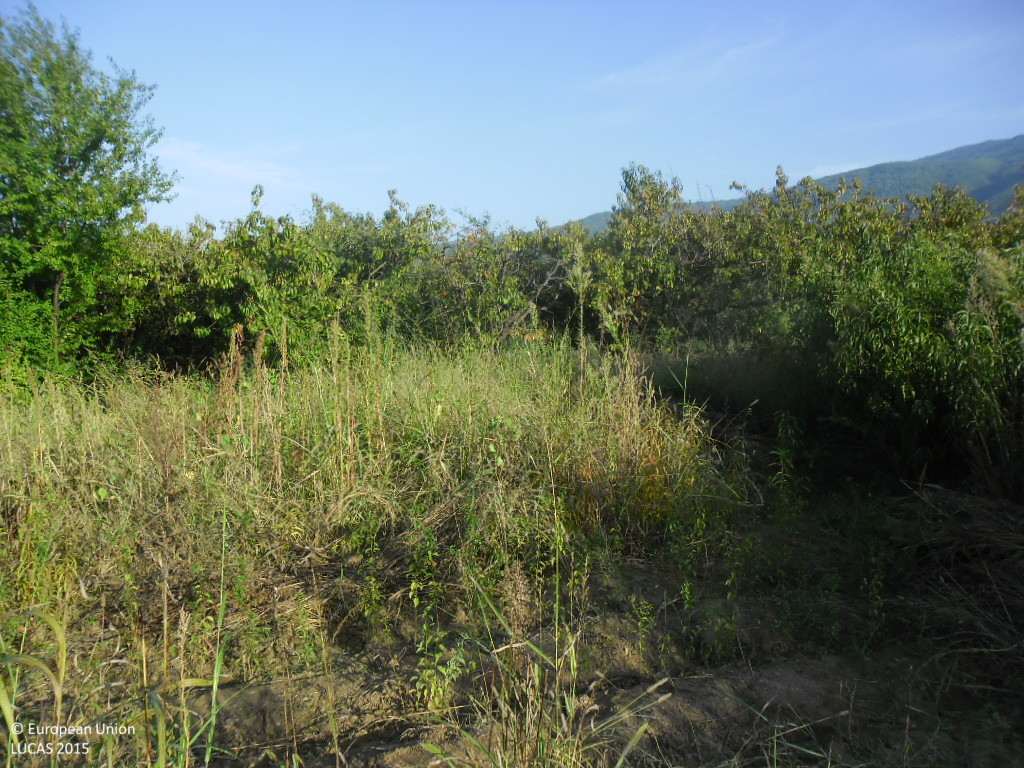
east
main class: Cropland
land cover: Pear fruit
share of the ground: > 75 %
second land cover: Grassland without tree/shrub cover
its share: 10 - 25 %
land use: Agriculture (excluding fallow land and kitchen gardens)
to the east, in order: Pear fruit; Grassland without tree/shrub cover; Other fruit trees and berries; Ditches and canals; Cherry fruit; Tomatoes; Other fruit trees and berries; Ditches and canals; Tracks; Other fresh vegetables; Other fruit trees and berries
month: September
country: BG
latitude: 41.3920
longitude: 23.1378
